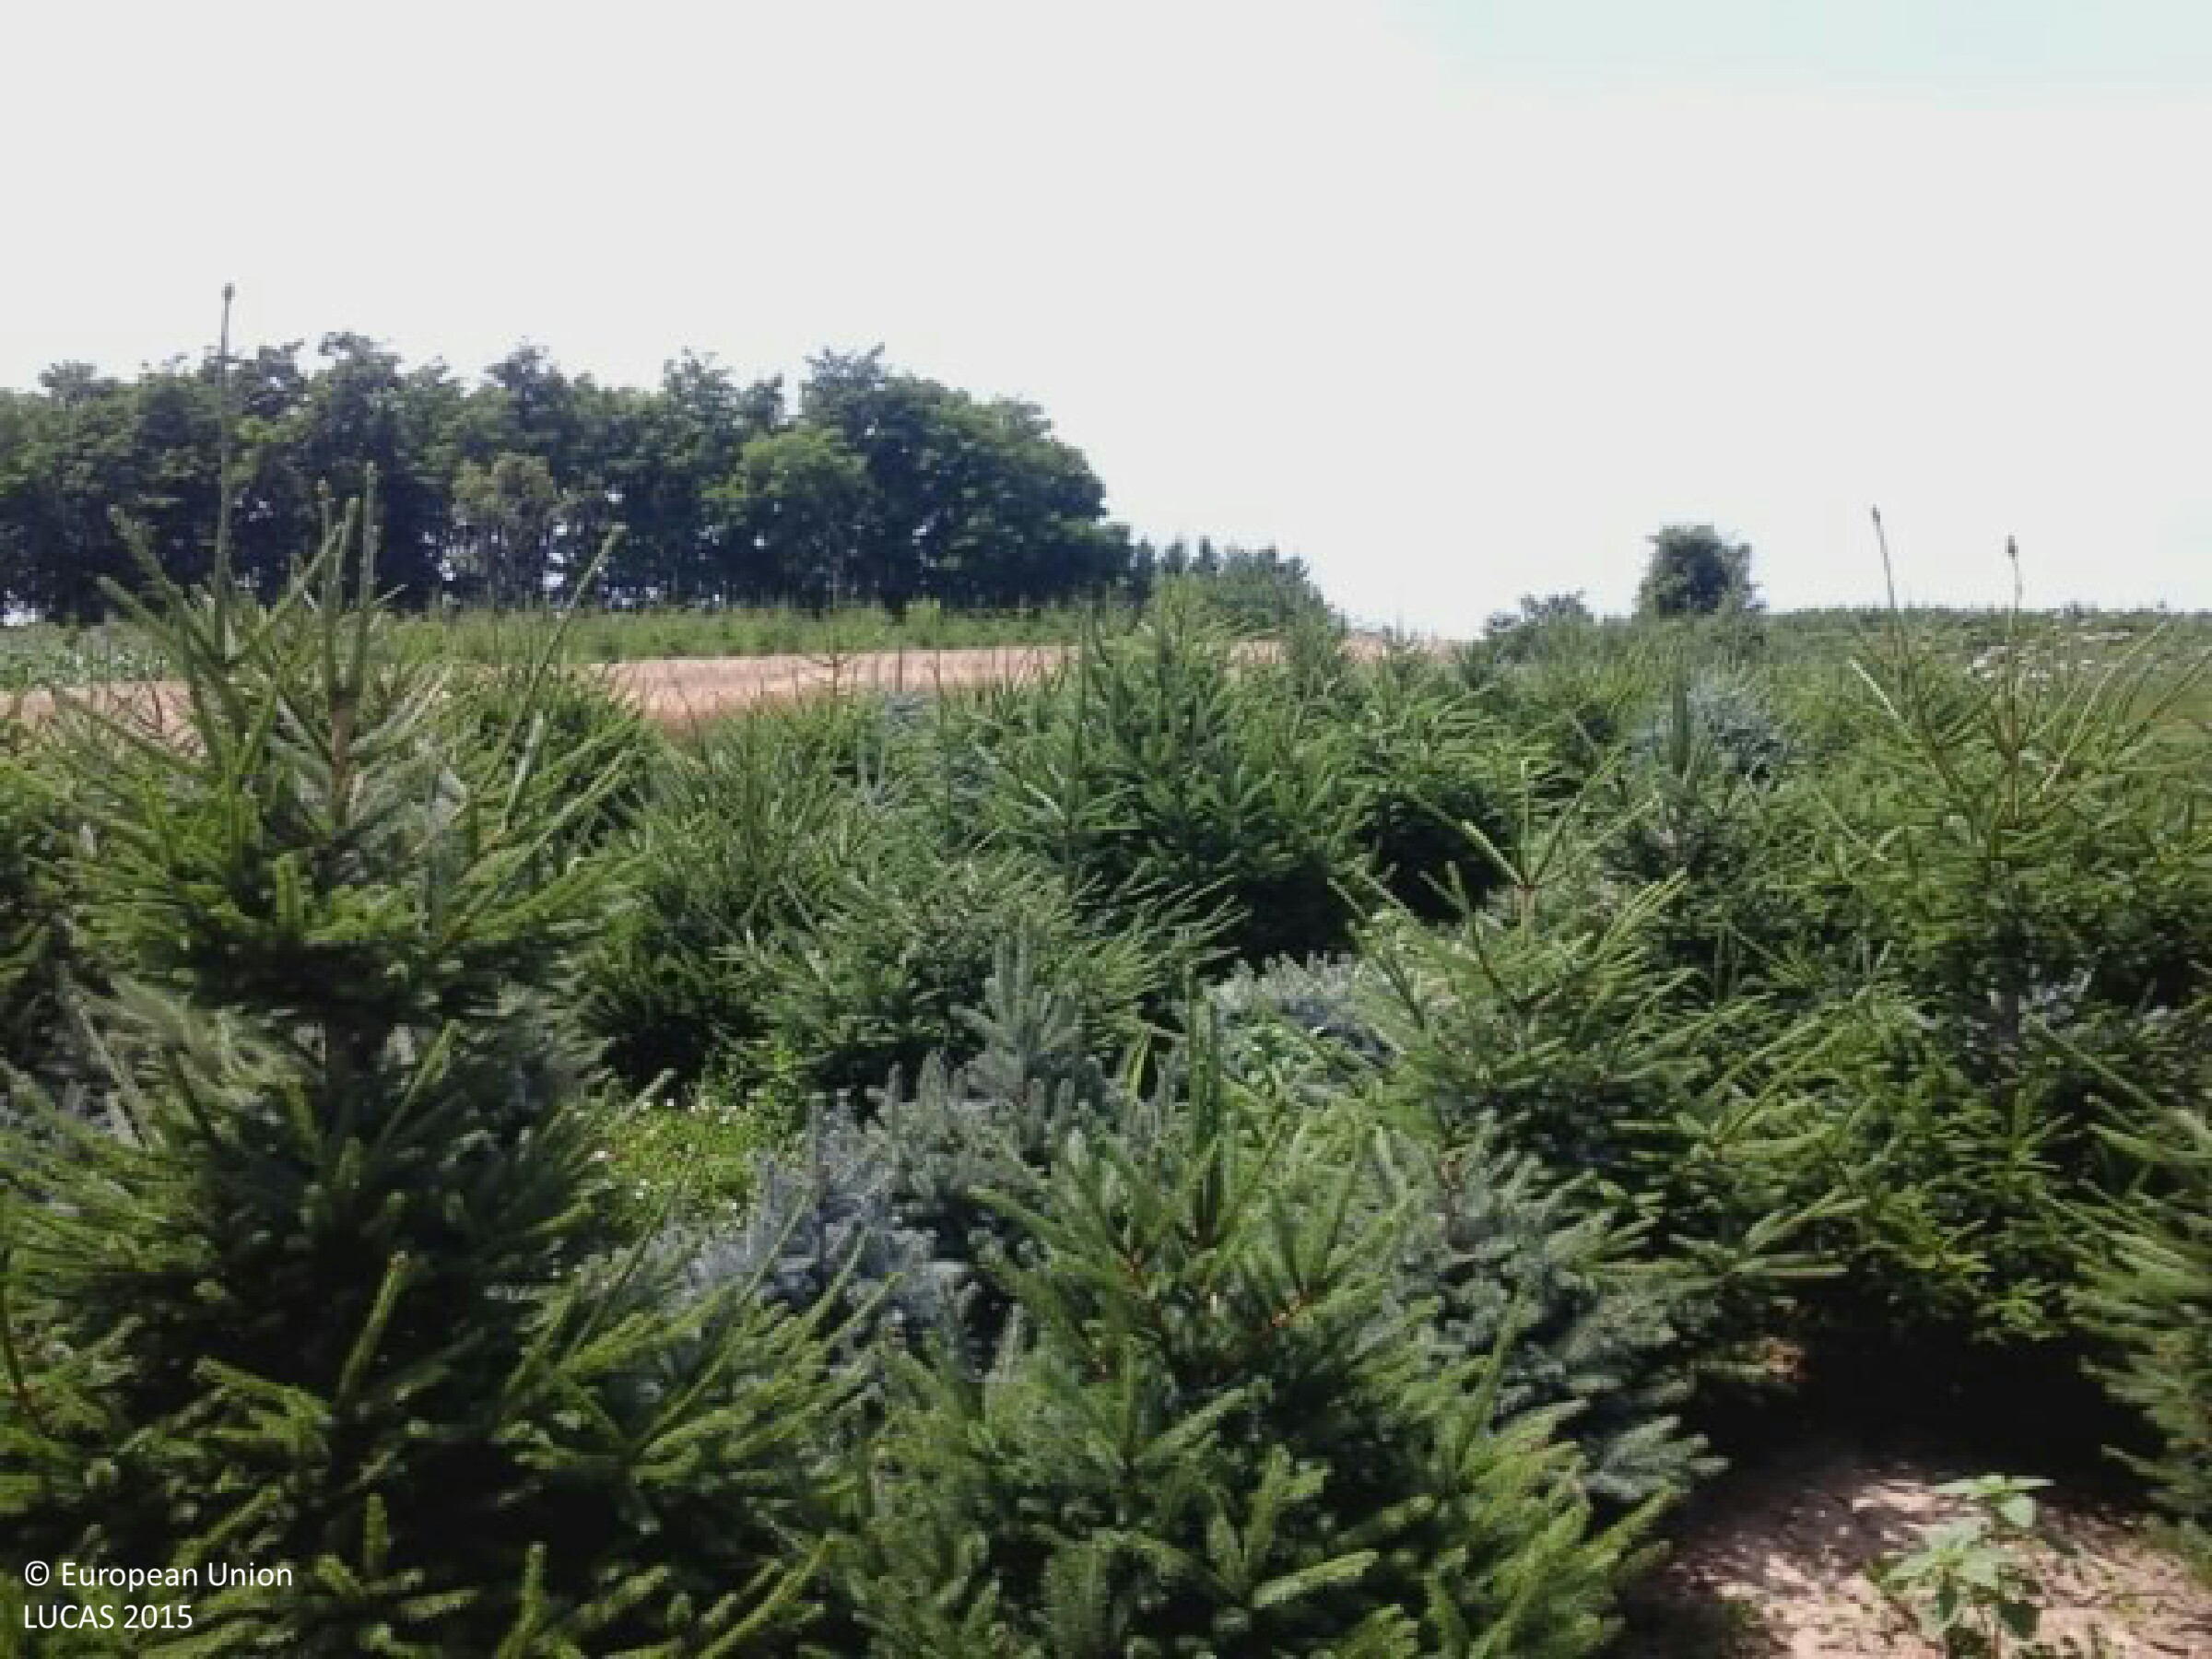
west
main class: Cropland
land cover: Nurseries
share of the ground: > 75 %
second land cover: Other bare soil
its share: > 75 %
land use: Agriculture (excluding fallow land and kitchen gardens)
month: June
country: HU
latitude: 46.4036
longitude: 17.3792
